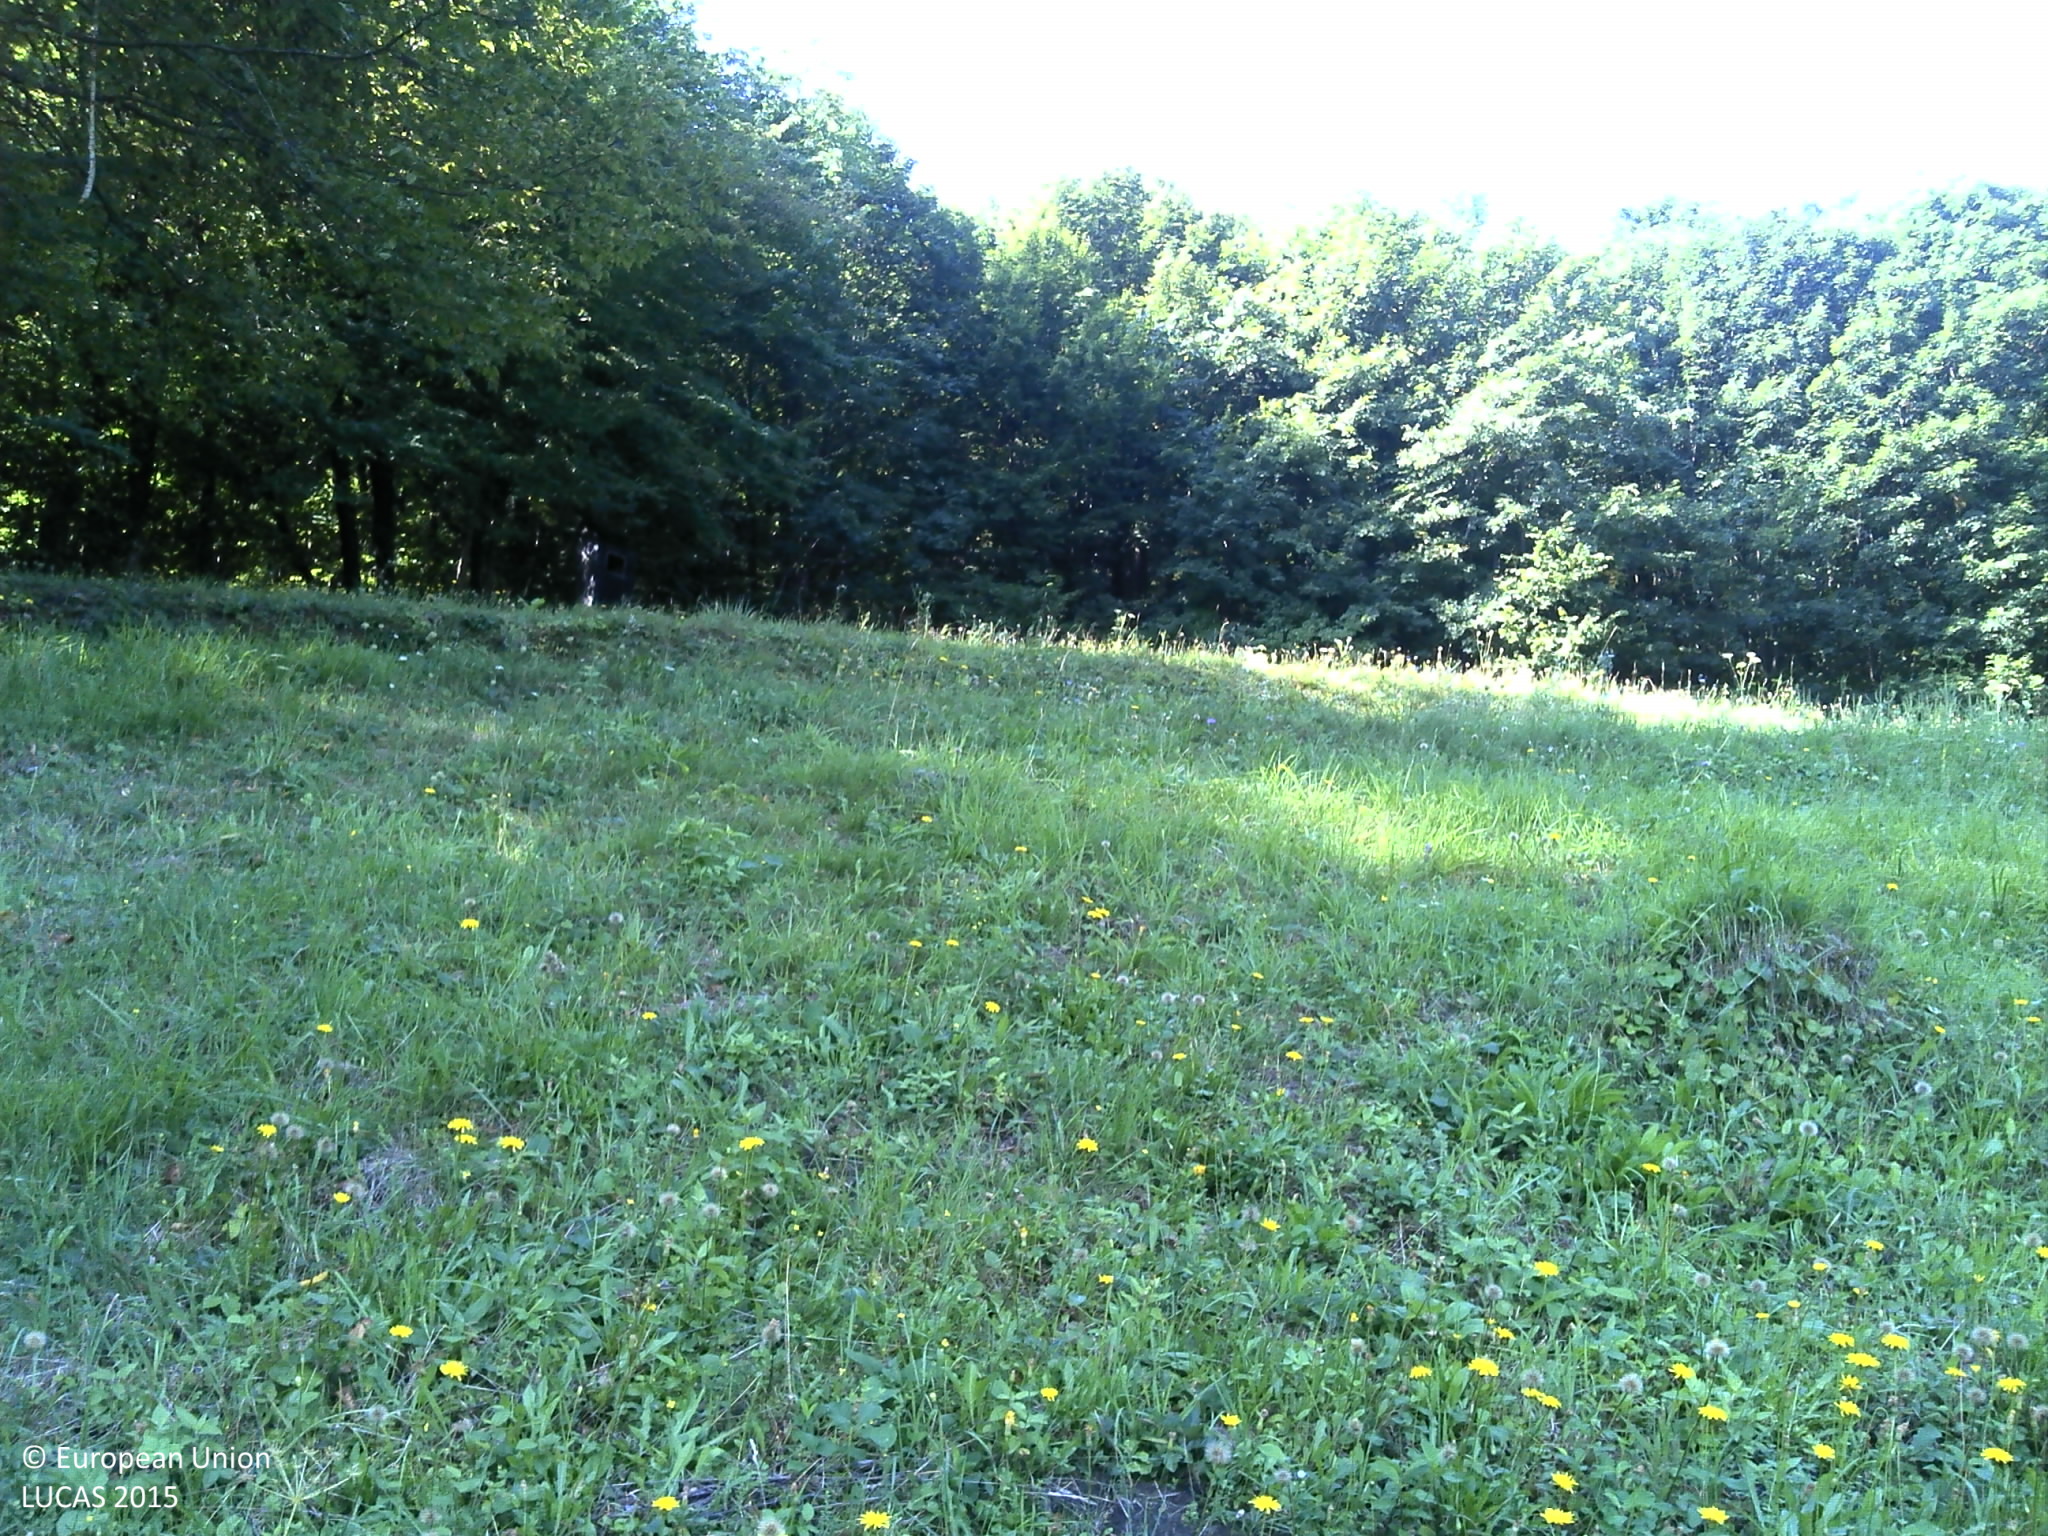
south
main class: Grassland
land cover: Spontaneously vegetated surfaces
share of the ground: > 75 %
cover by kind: herbaceous plants 100 %
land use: Fallow land
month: August
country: HR
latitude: 45.2111
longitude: 15.2538
